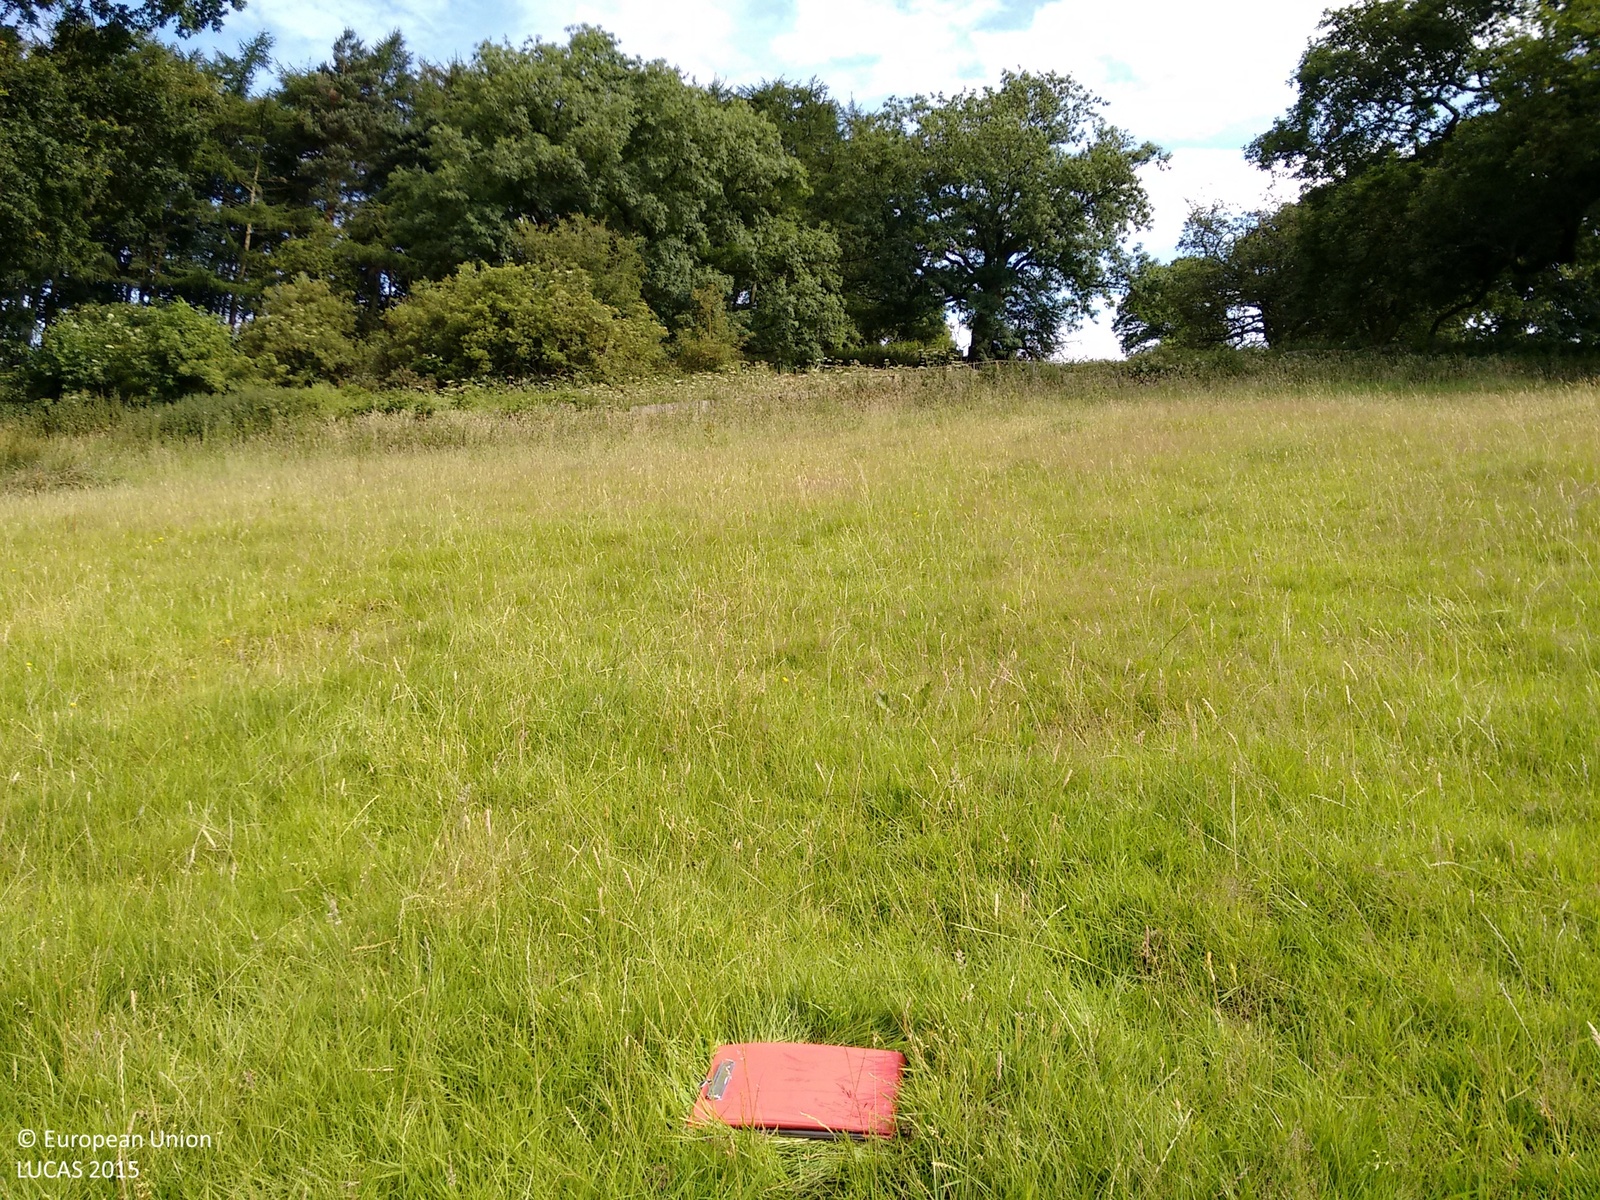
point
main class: Grassland
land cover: Grassland without tree/shrub cover
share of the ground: > 75 %
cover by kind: herbaceous plants 100 %
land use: Agriculture (excluding fallow land and kitchen gardens)
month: July
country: GB
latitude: 53.2062
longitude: -1.5952
